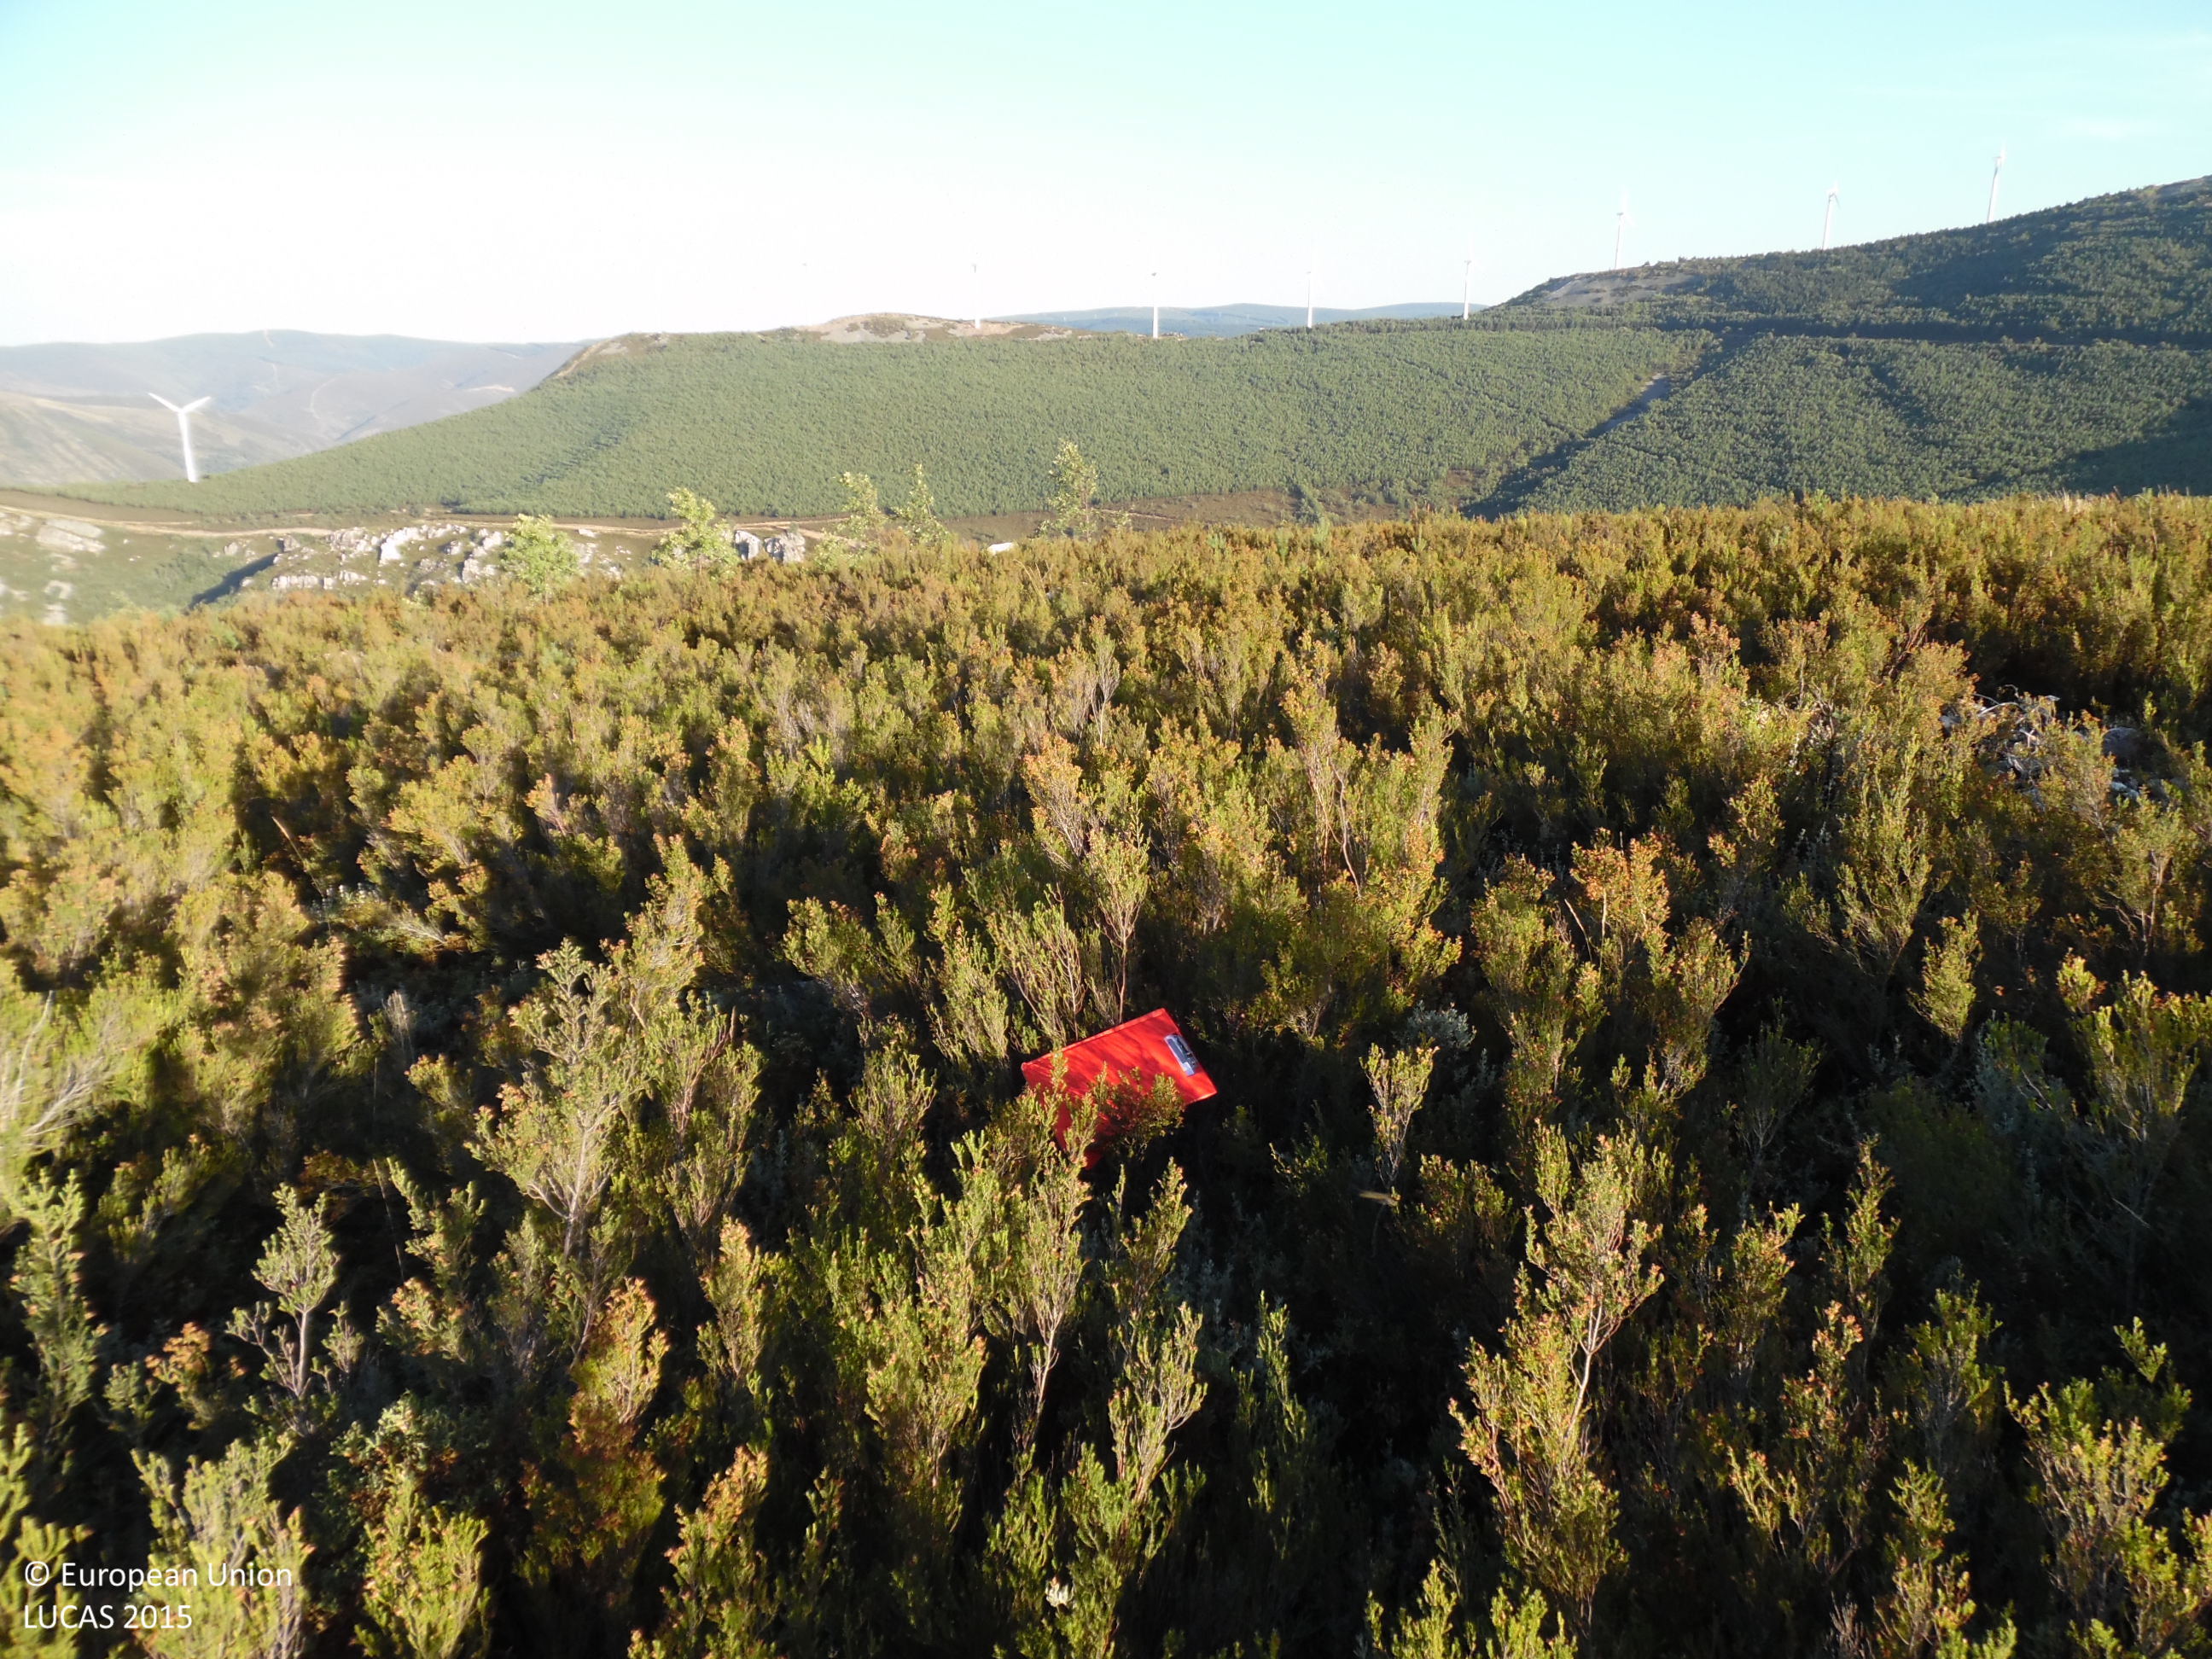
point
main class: Shrubland
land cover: Shrubland without tree cover
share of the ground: > 75 %
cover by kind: shrubs 100 %
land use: Forestry
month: July
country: ES
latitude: 42.5572
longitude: -6.3992
